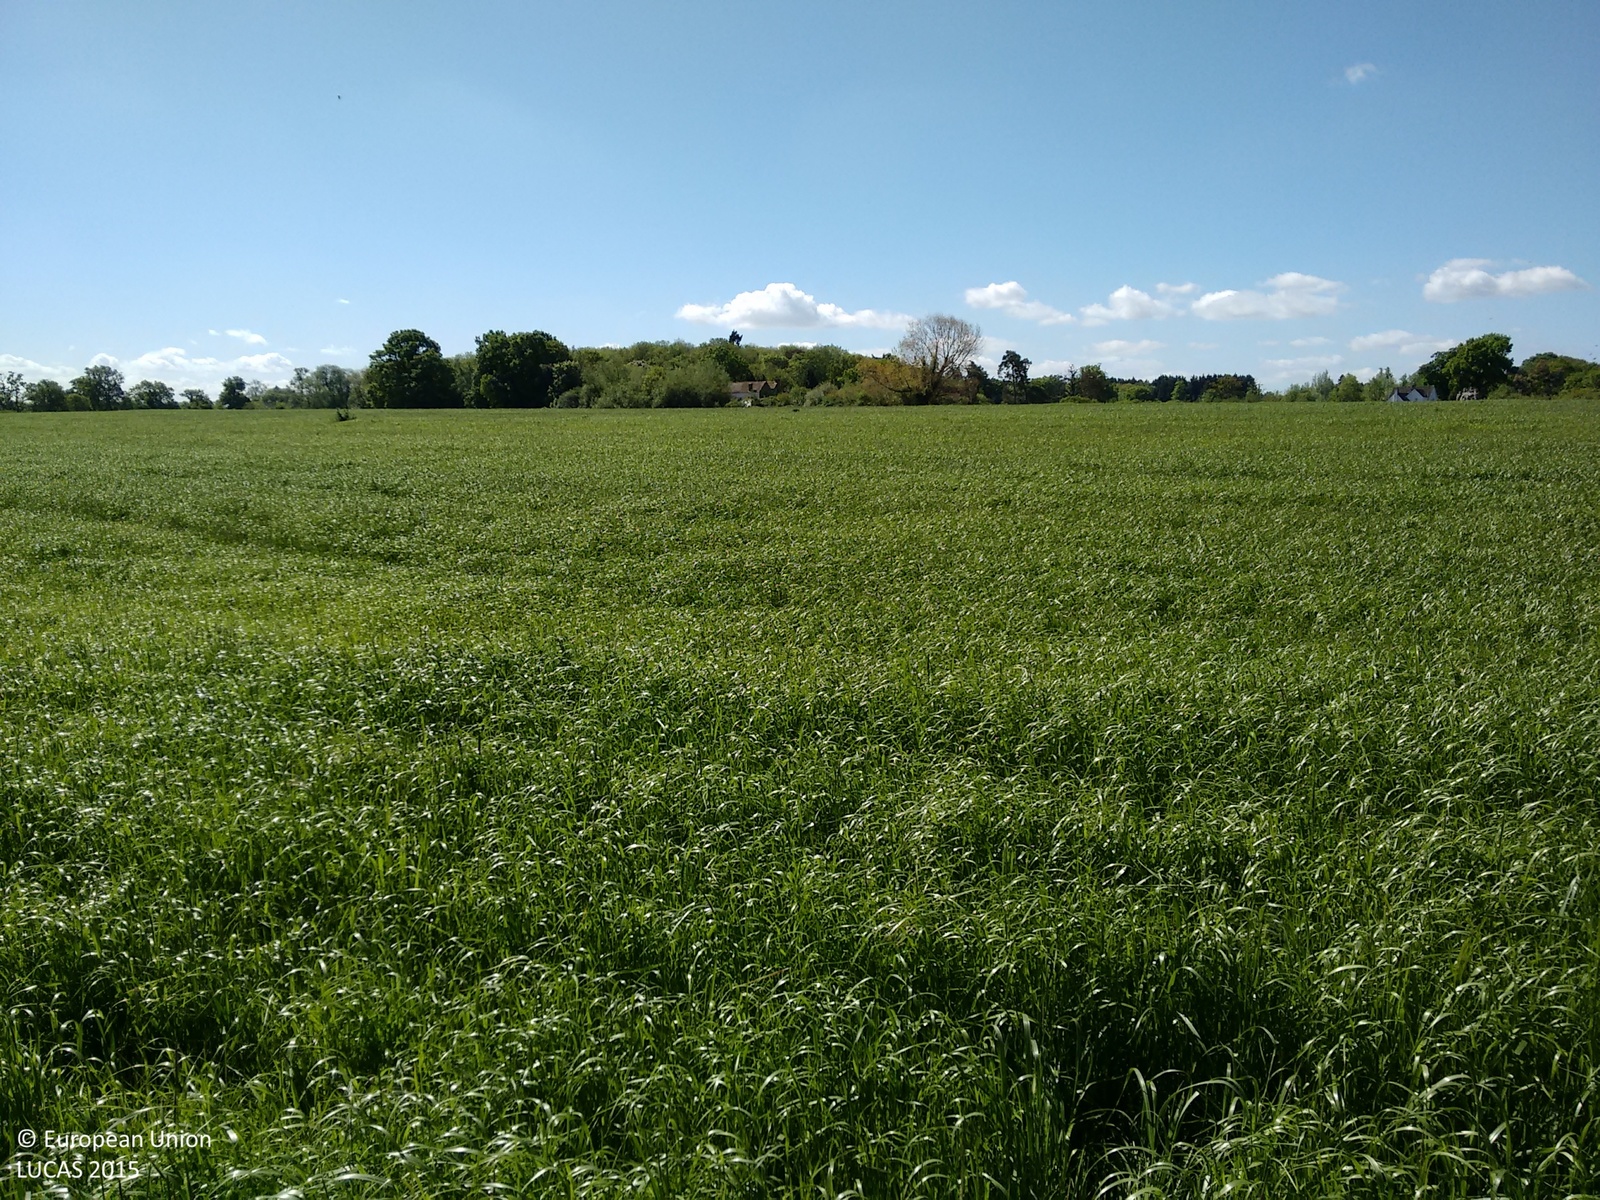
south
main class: Cropland
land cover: Barley
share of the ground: > 75 %
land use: Agriculture (excluding fallow land and kitchen gardens)
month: May
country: GB
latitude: 51.3180
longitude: -1.0212
